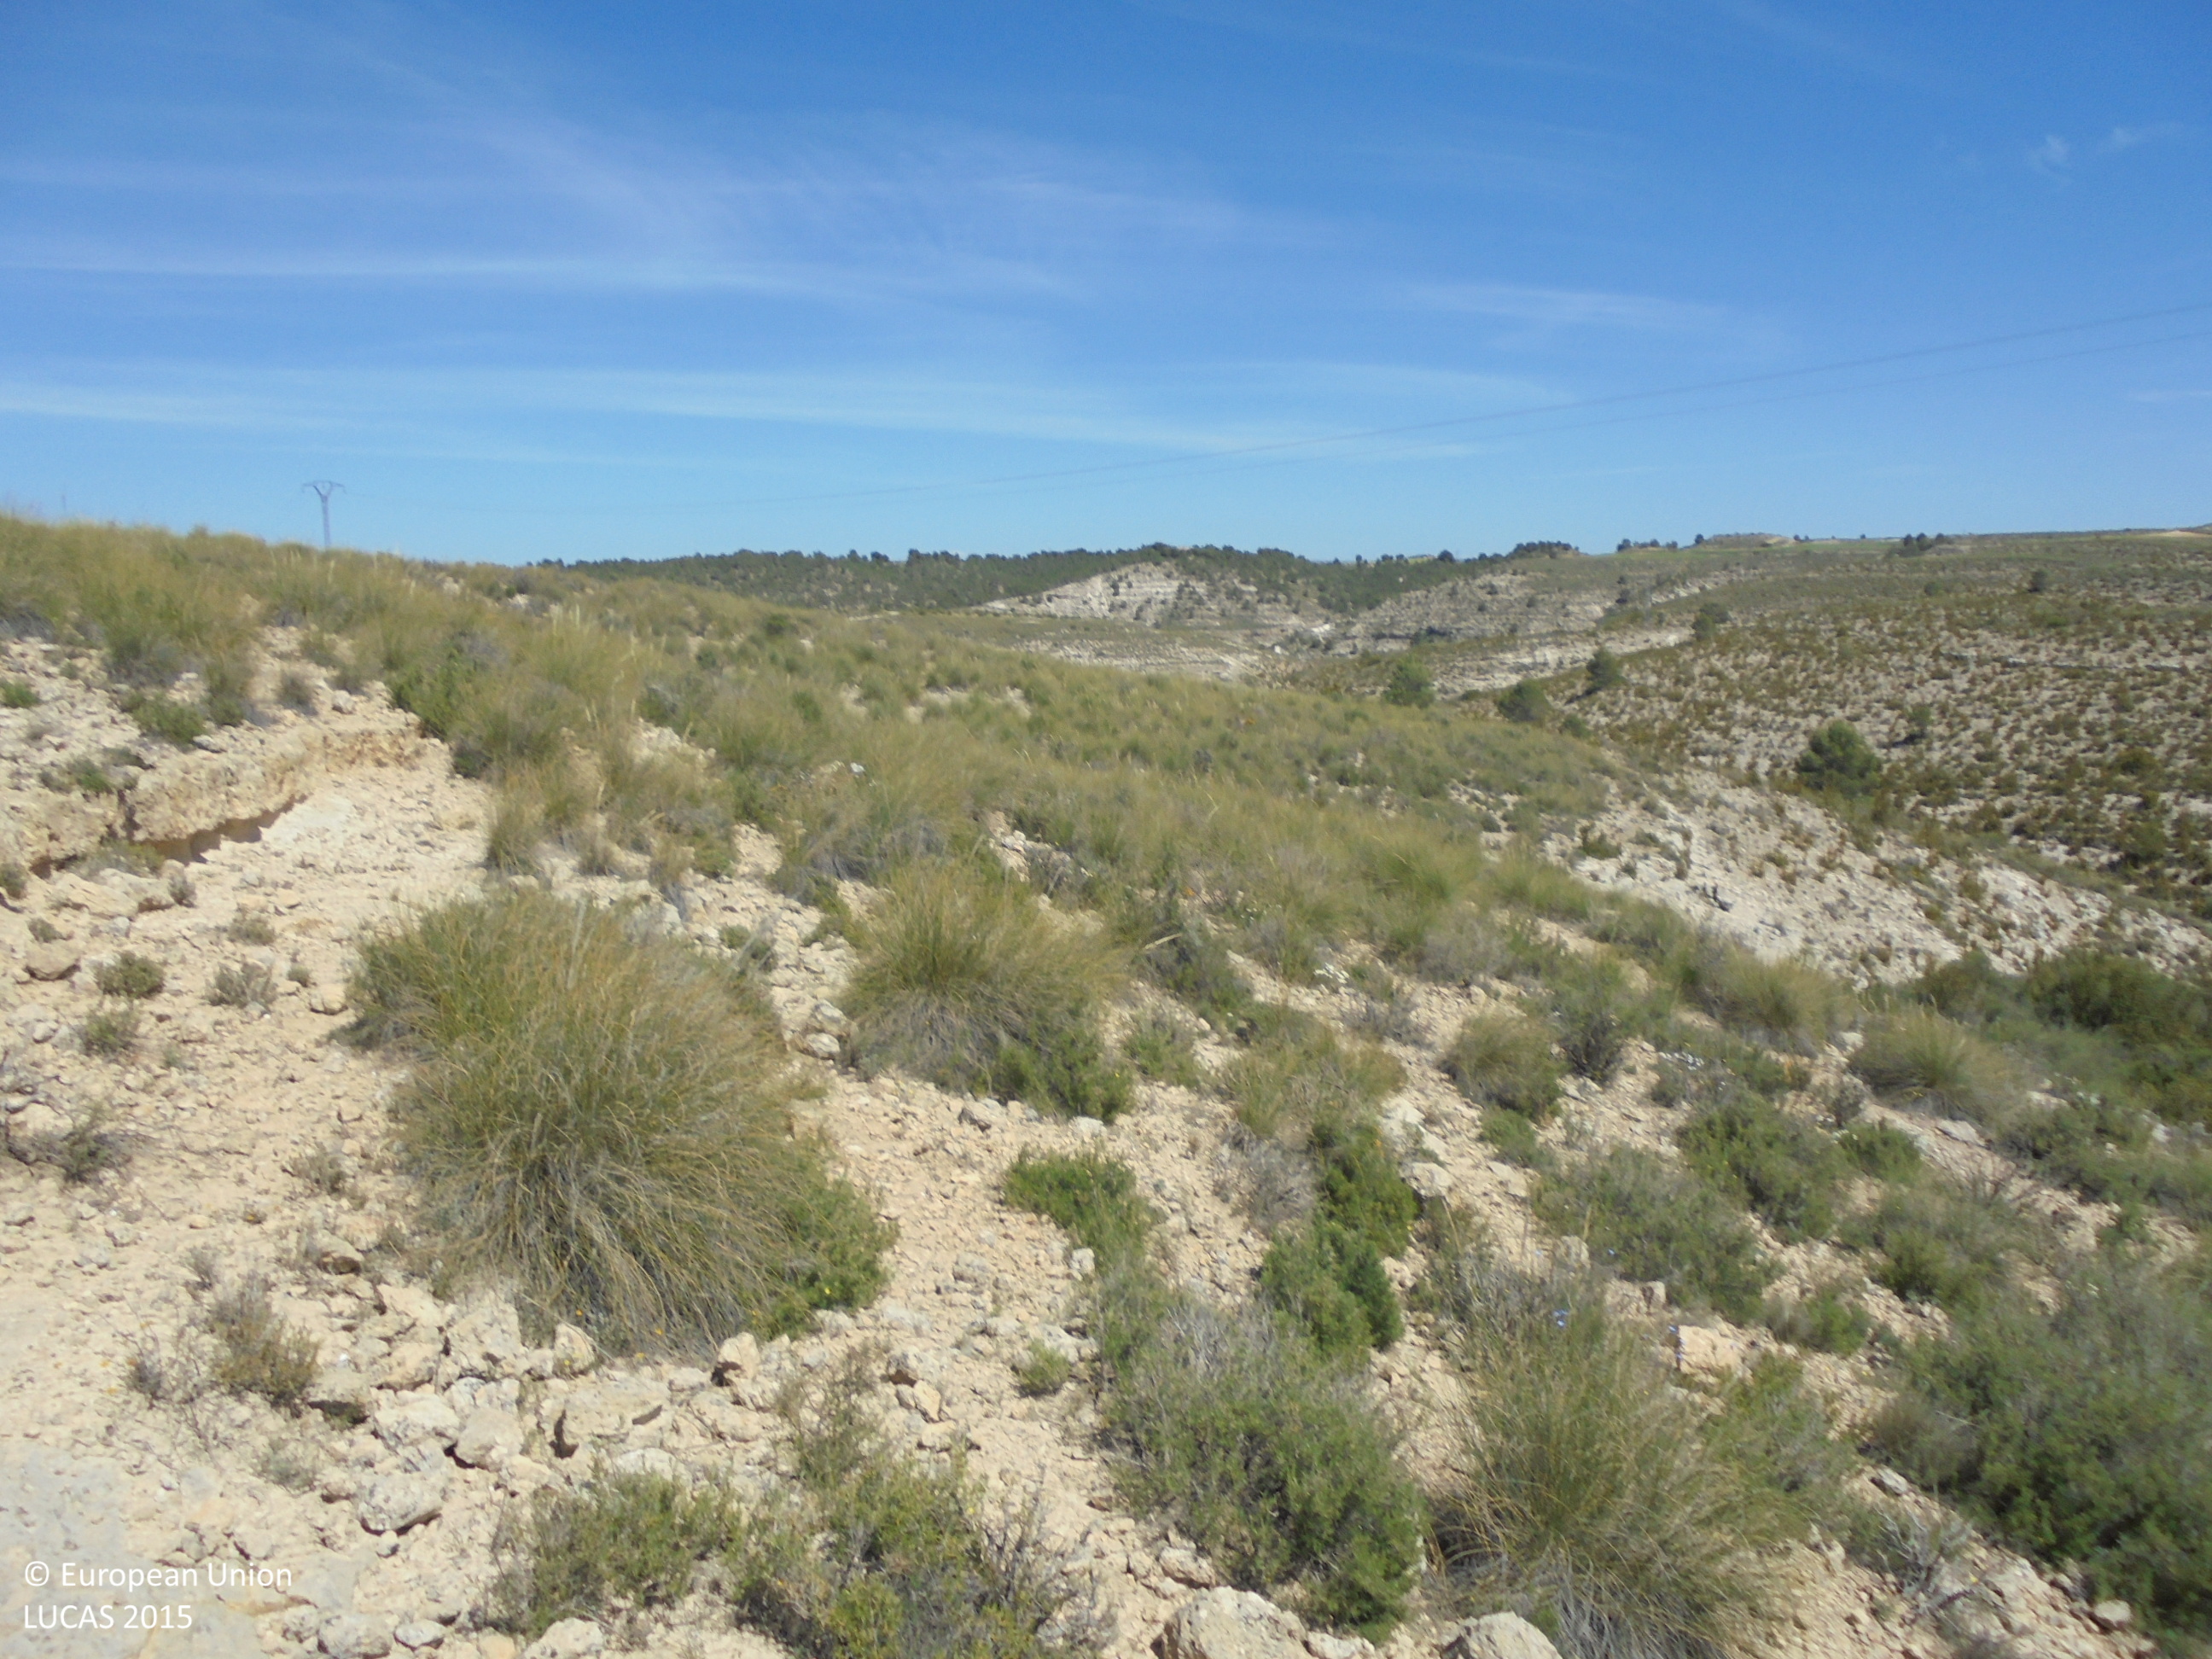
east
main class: Shrubland
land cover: Shrubland without tree cover
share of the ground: 50 - 75 %
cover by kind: shrubs 50 %, consolidated bare surface 35 %, herbaceous plants 15 %
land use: Semi-natural and natural areas not in use
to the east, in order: Shrubland without tree cover; Electric lines; Shrubland without tree cover
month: May
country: ES
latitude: 39.1530
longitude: -1.6303
